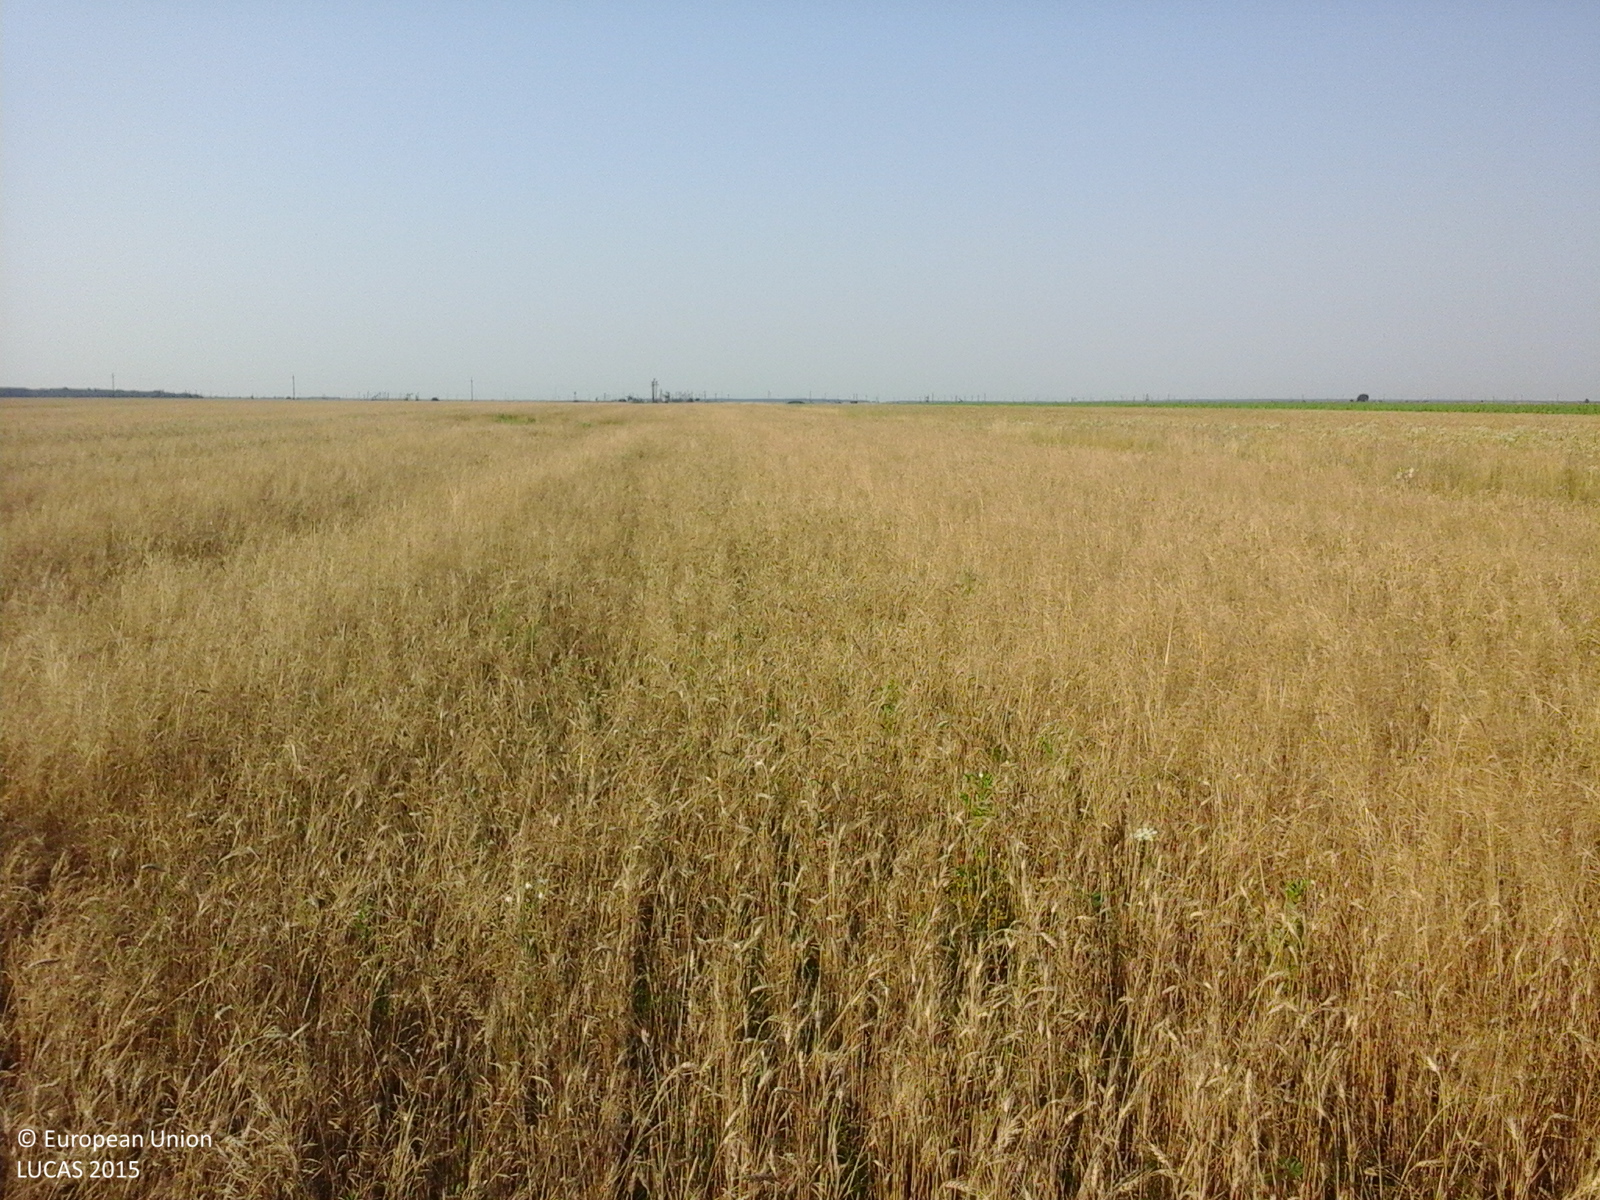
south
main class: Cropland
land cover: Common wheat
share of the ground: > 75 %
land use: Agriculture (excluding fallow land and kitchen gardens)
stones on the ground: < 10 %
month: July
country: RO
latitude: 44.4796
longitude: 25.0046
